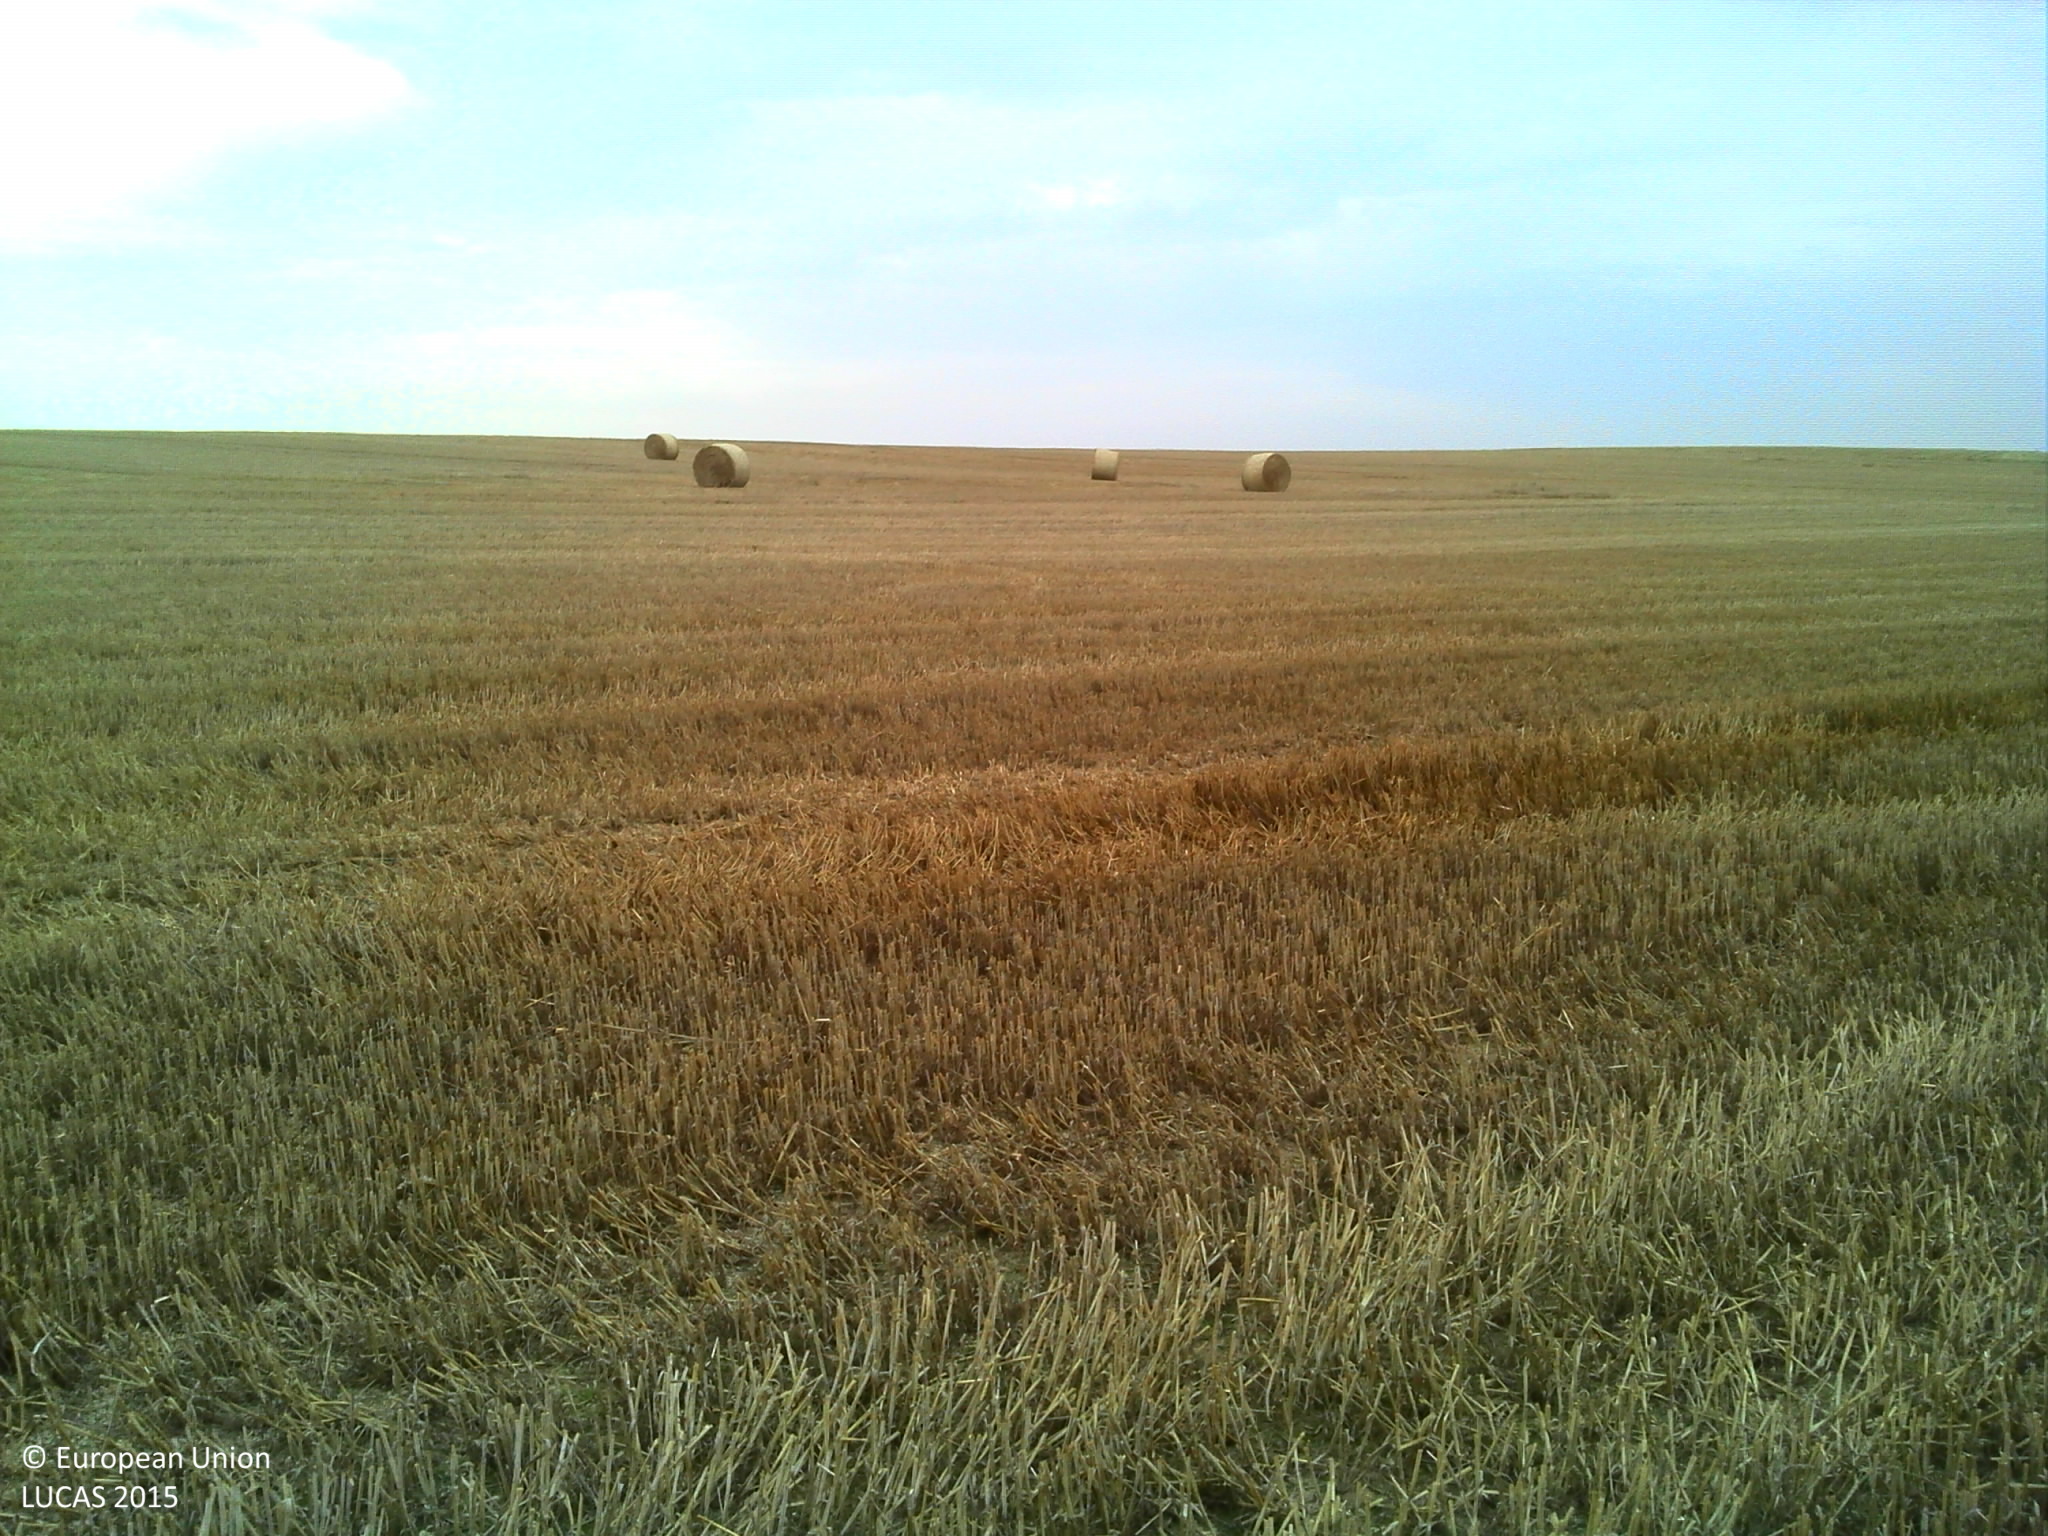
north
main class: Cropland
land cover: Common wheat
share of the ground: < 10 %
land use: Agriculture (excluding fallow land and kitchen gardens)
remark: Harvested field
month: August
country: BE
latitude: 50.6623
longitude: 3.7544
